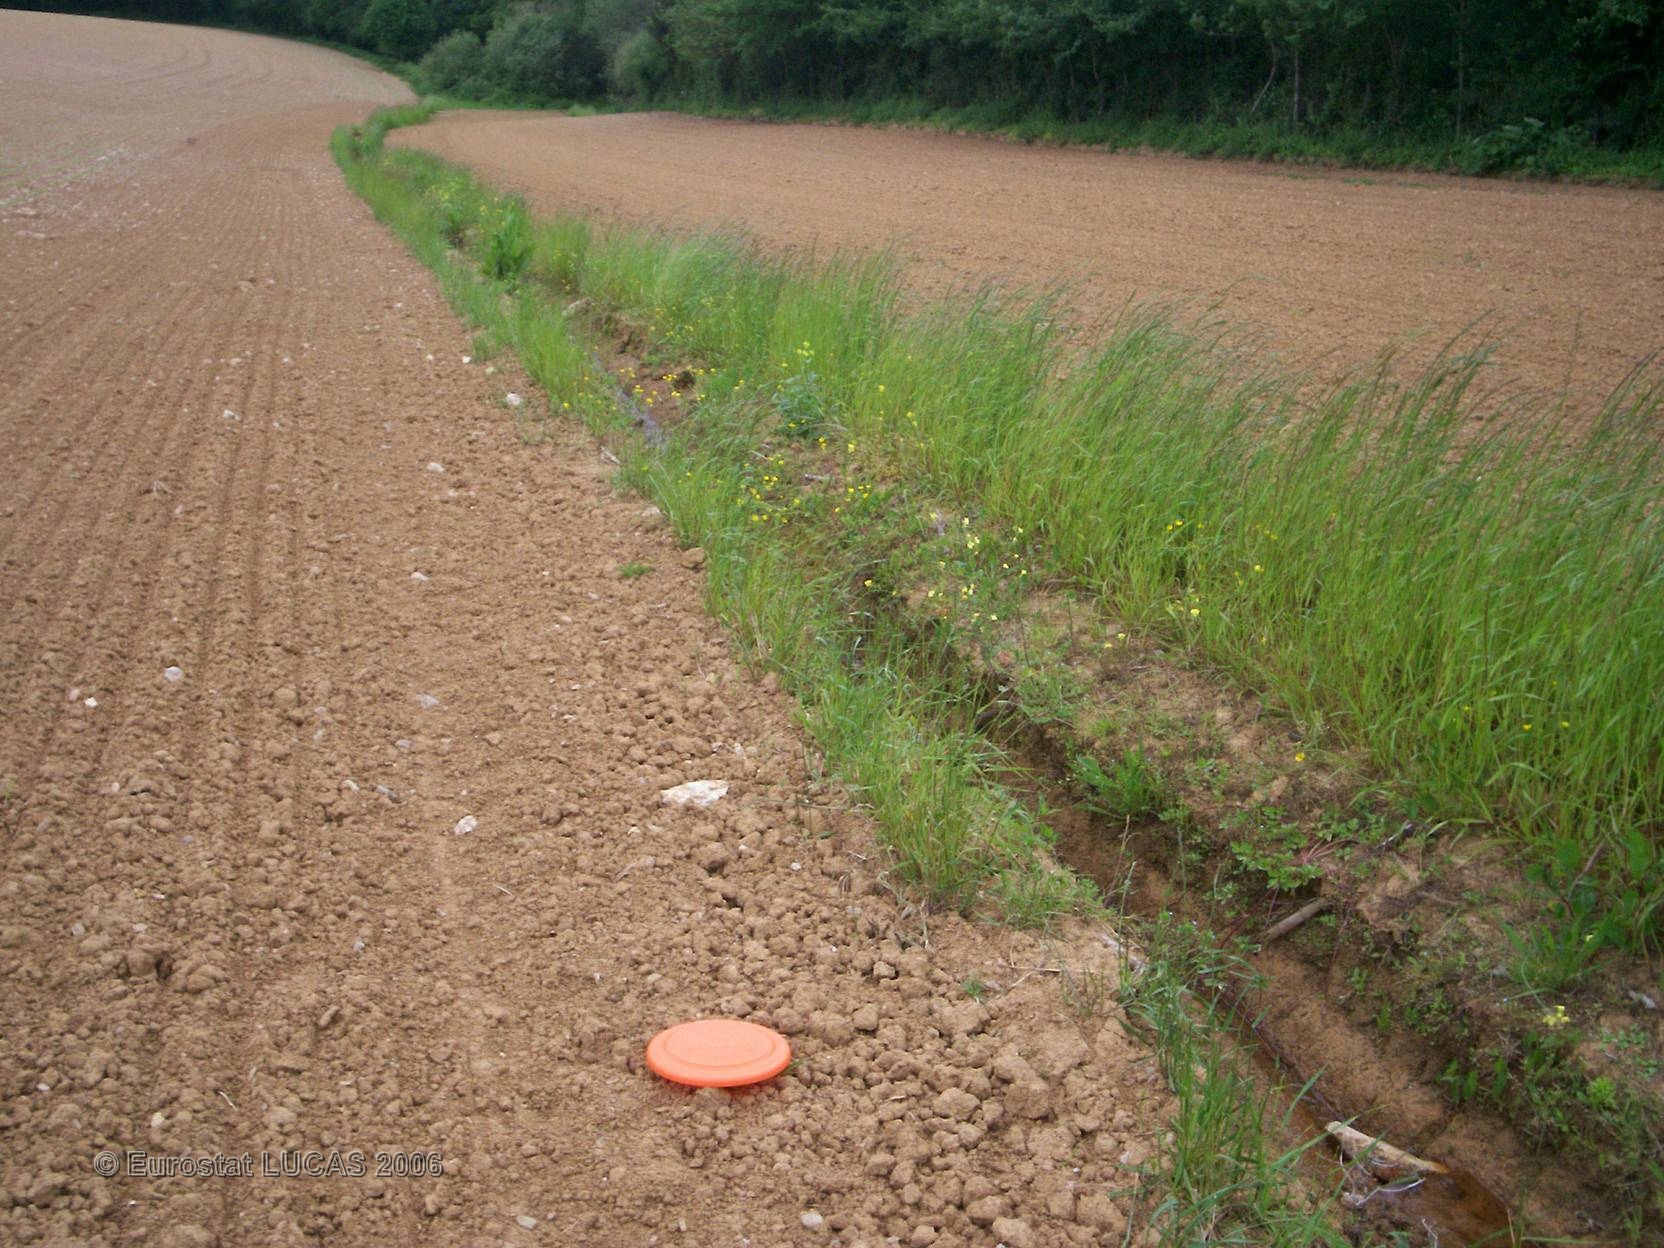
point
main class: Grassland
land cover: Grassland without tree/shrub cover
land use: Agriculture (excluding fallow land and kitchen gardens)
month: May
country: FR
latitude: 46.5077
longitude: -0.8337
